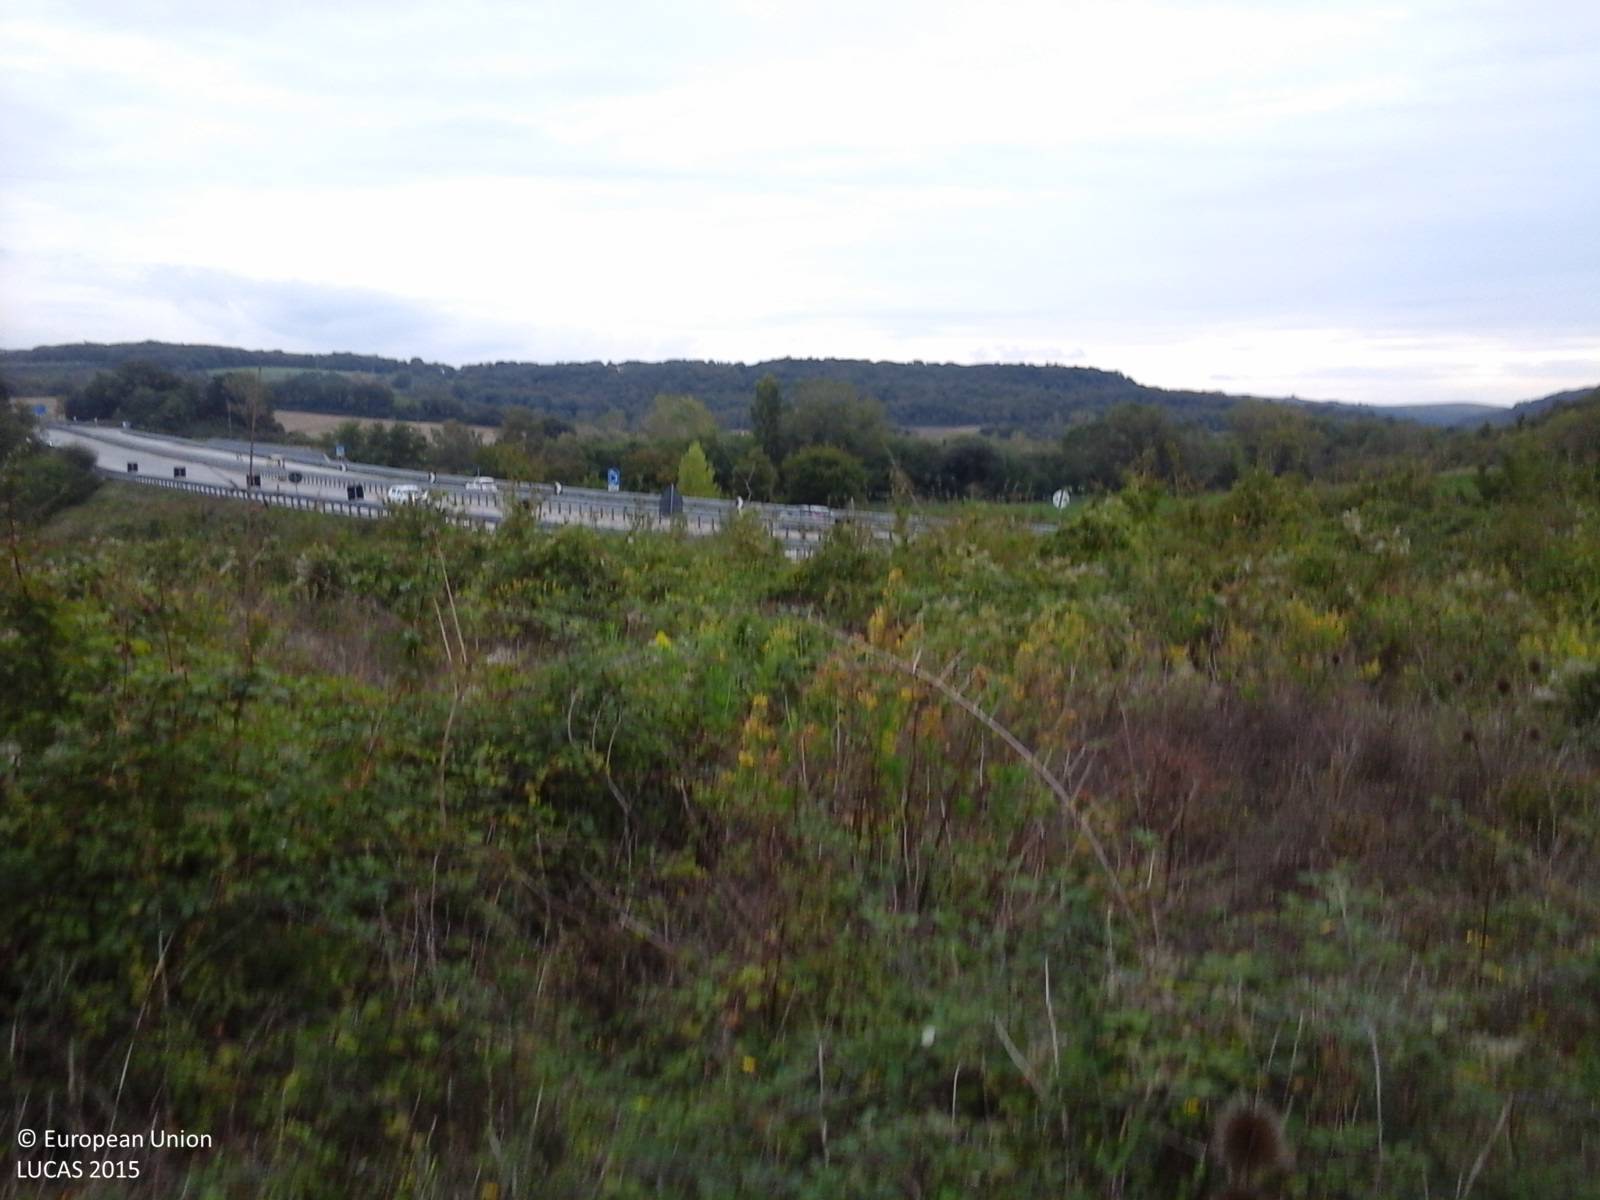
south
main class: Shrubland
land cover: Shrubland without tree cover
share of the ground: > 75 %
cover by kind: shrubs 90 %, herbaceous plants 10 %
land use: Abandoned areas
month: October
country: IT
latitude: 43.3098
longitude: 11.5859
